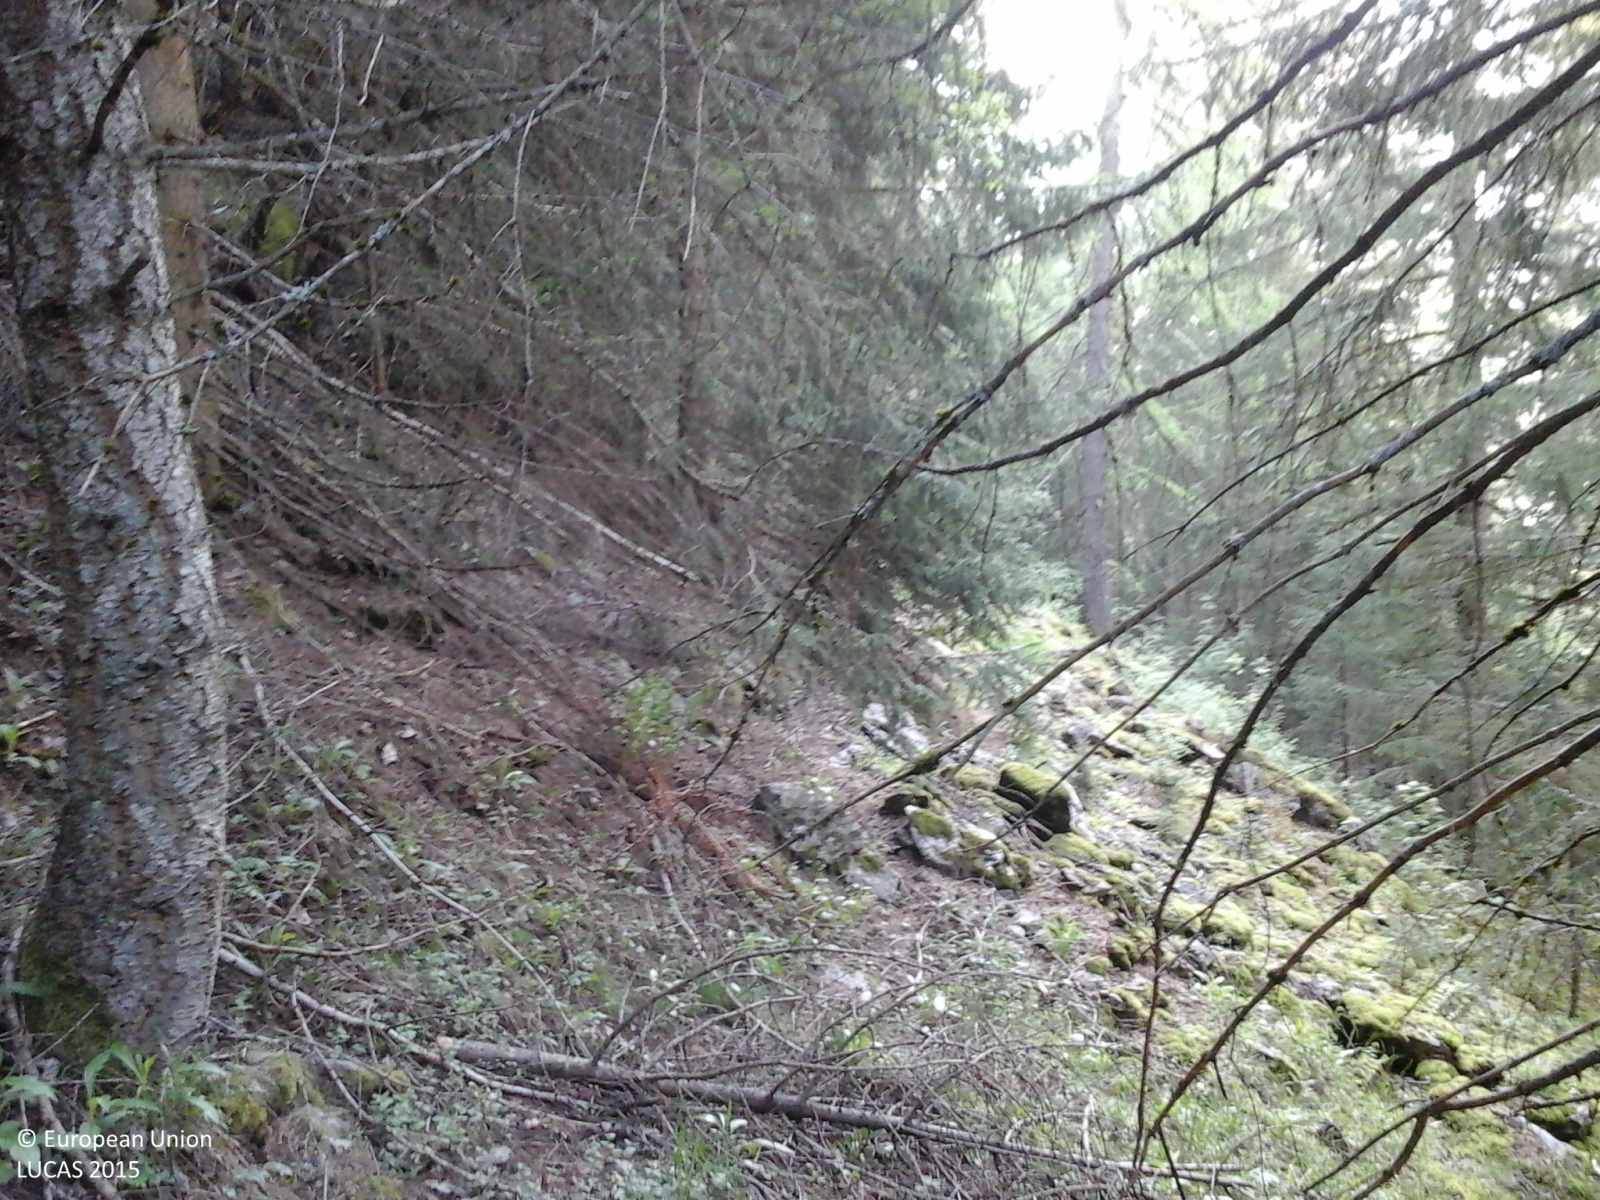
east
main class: Woodland
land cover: Spruce dominated coniferous woodland
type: alpine coniferous forest
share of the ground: > 75 %
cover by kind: coniferous forest trees 100 %
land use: Forestry
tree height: > 5 m
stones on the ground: > 50 %
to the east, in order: Spruce dominated coniferous woodland; Tracks; Spruce dominated coniferous woodland; Rocks and stones; Spruce dominated coniferous woodland; Rocks and stones
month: May
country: IT
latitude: 46.4918
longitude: 10.8718
